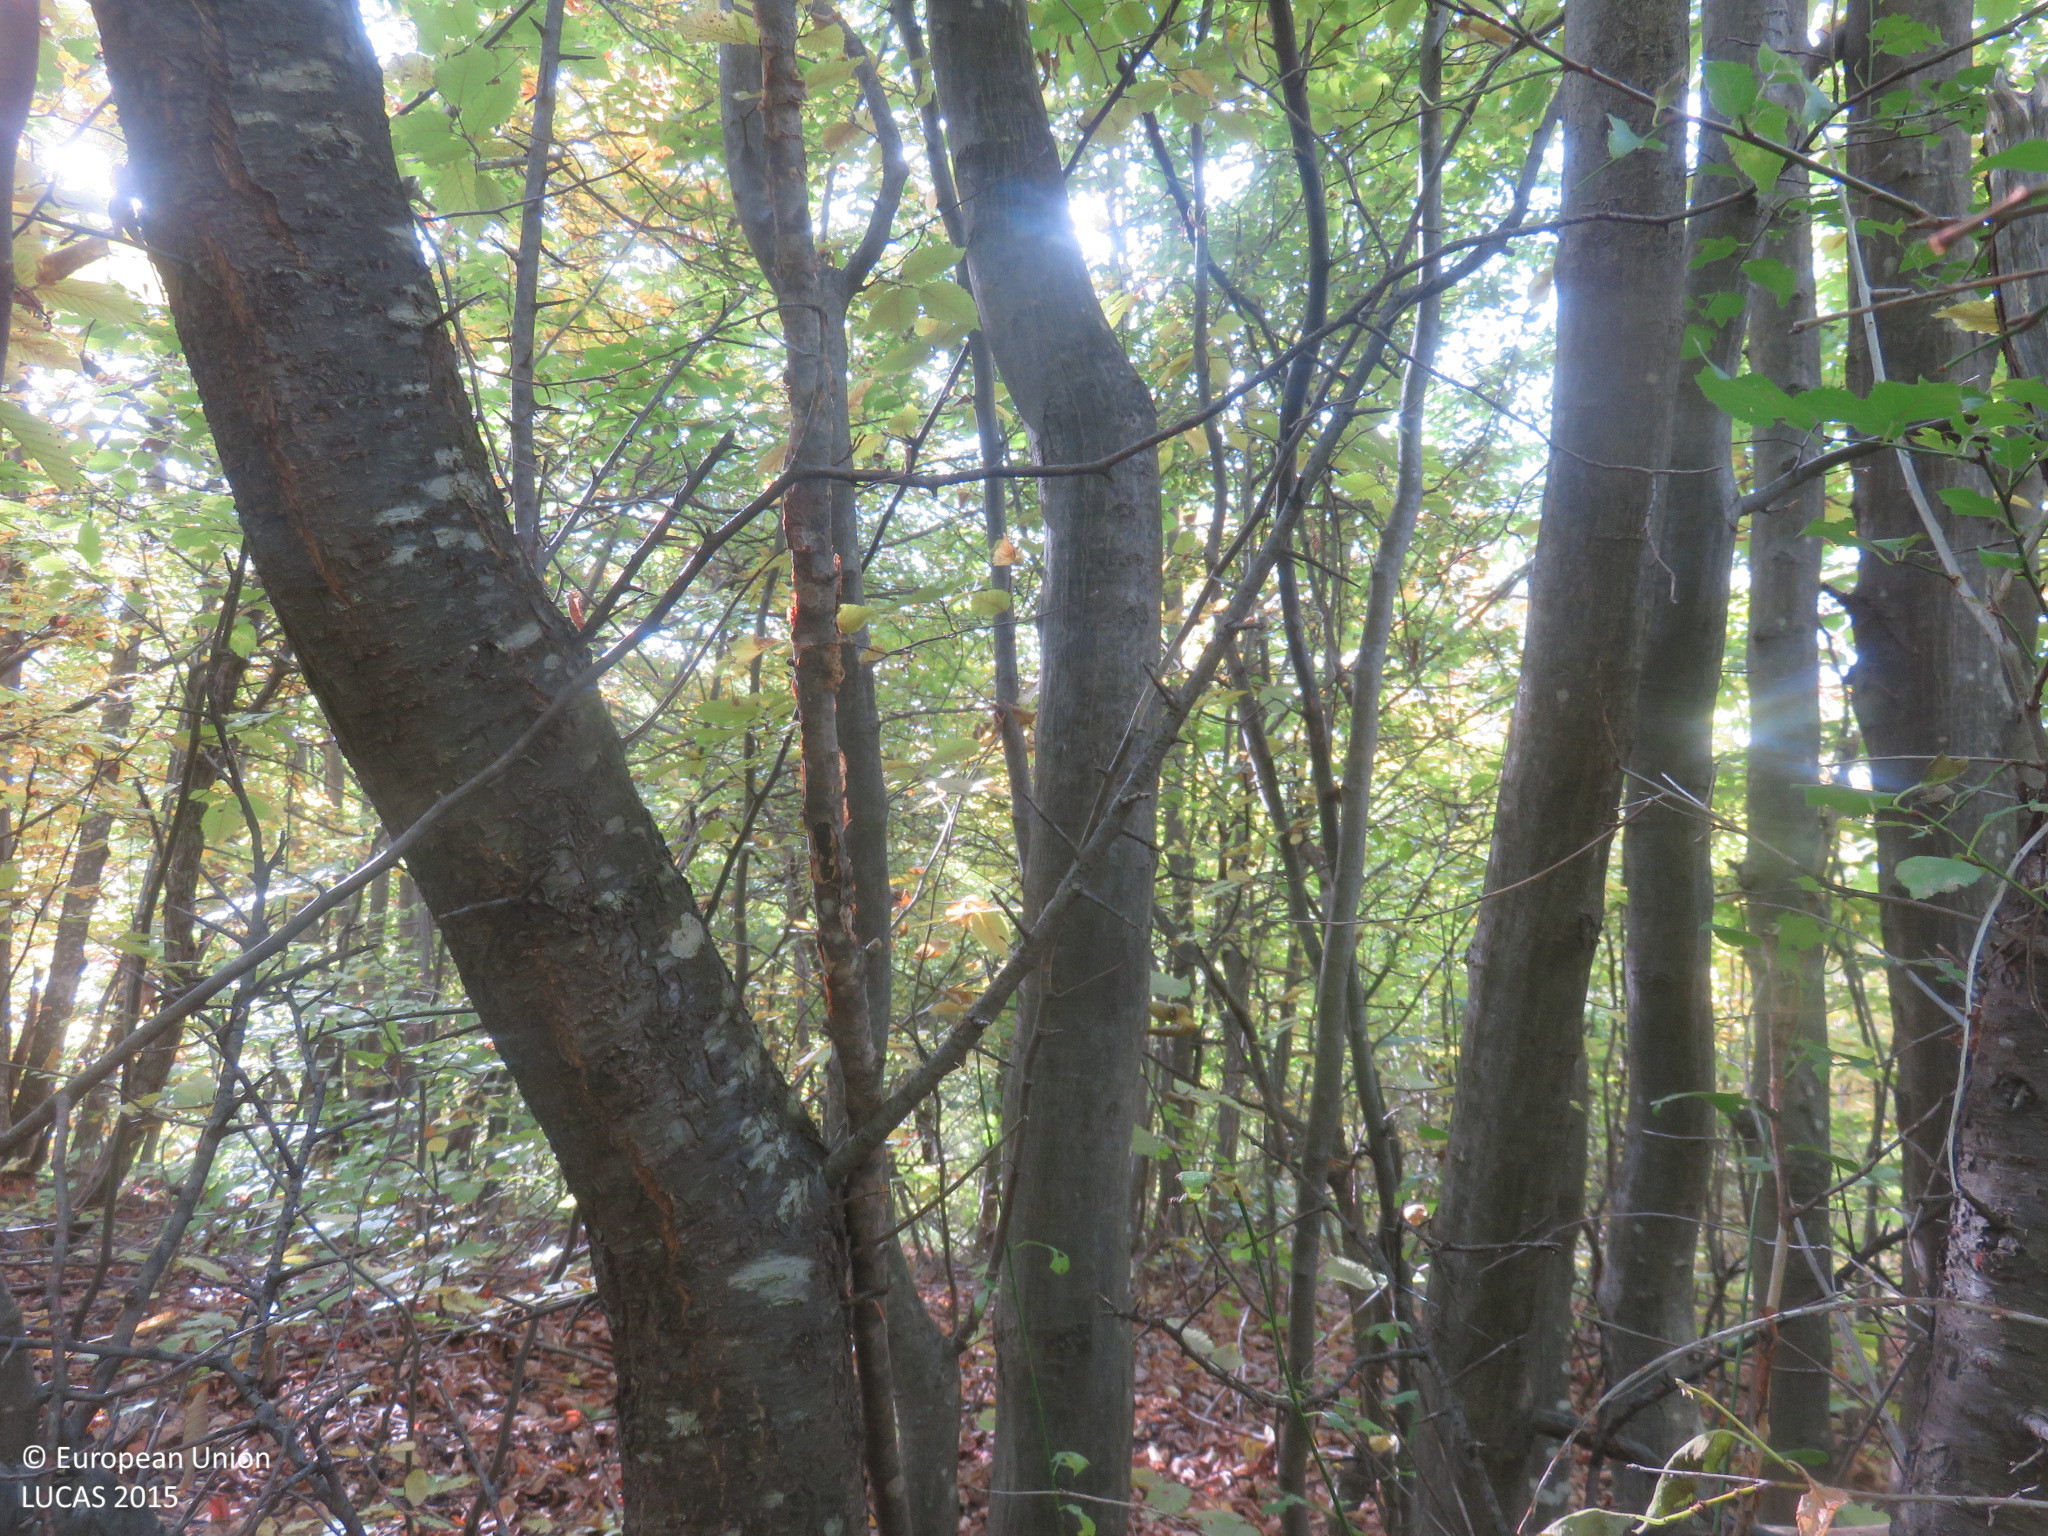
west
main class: Woodland
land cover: Broadleaved woodland
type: beech forest
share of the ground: > 75 %
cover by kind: broadleaved forest trees 95 %, shrubs 5 %
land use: Forestry
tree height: > 5 m
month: October
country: BG
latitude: 42.7855
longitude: 24.9393
